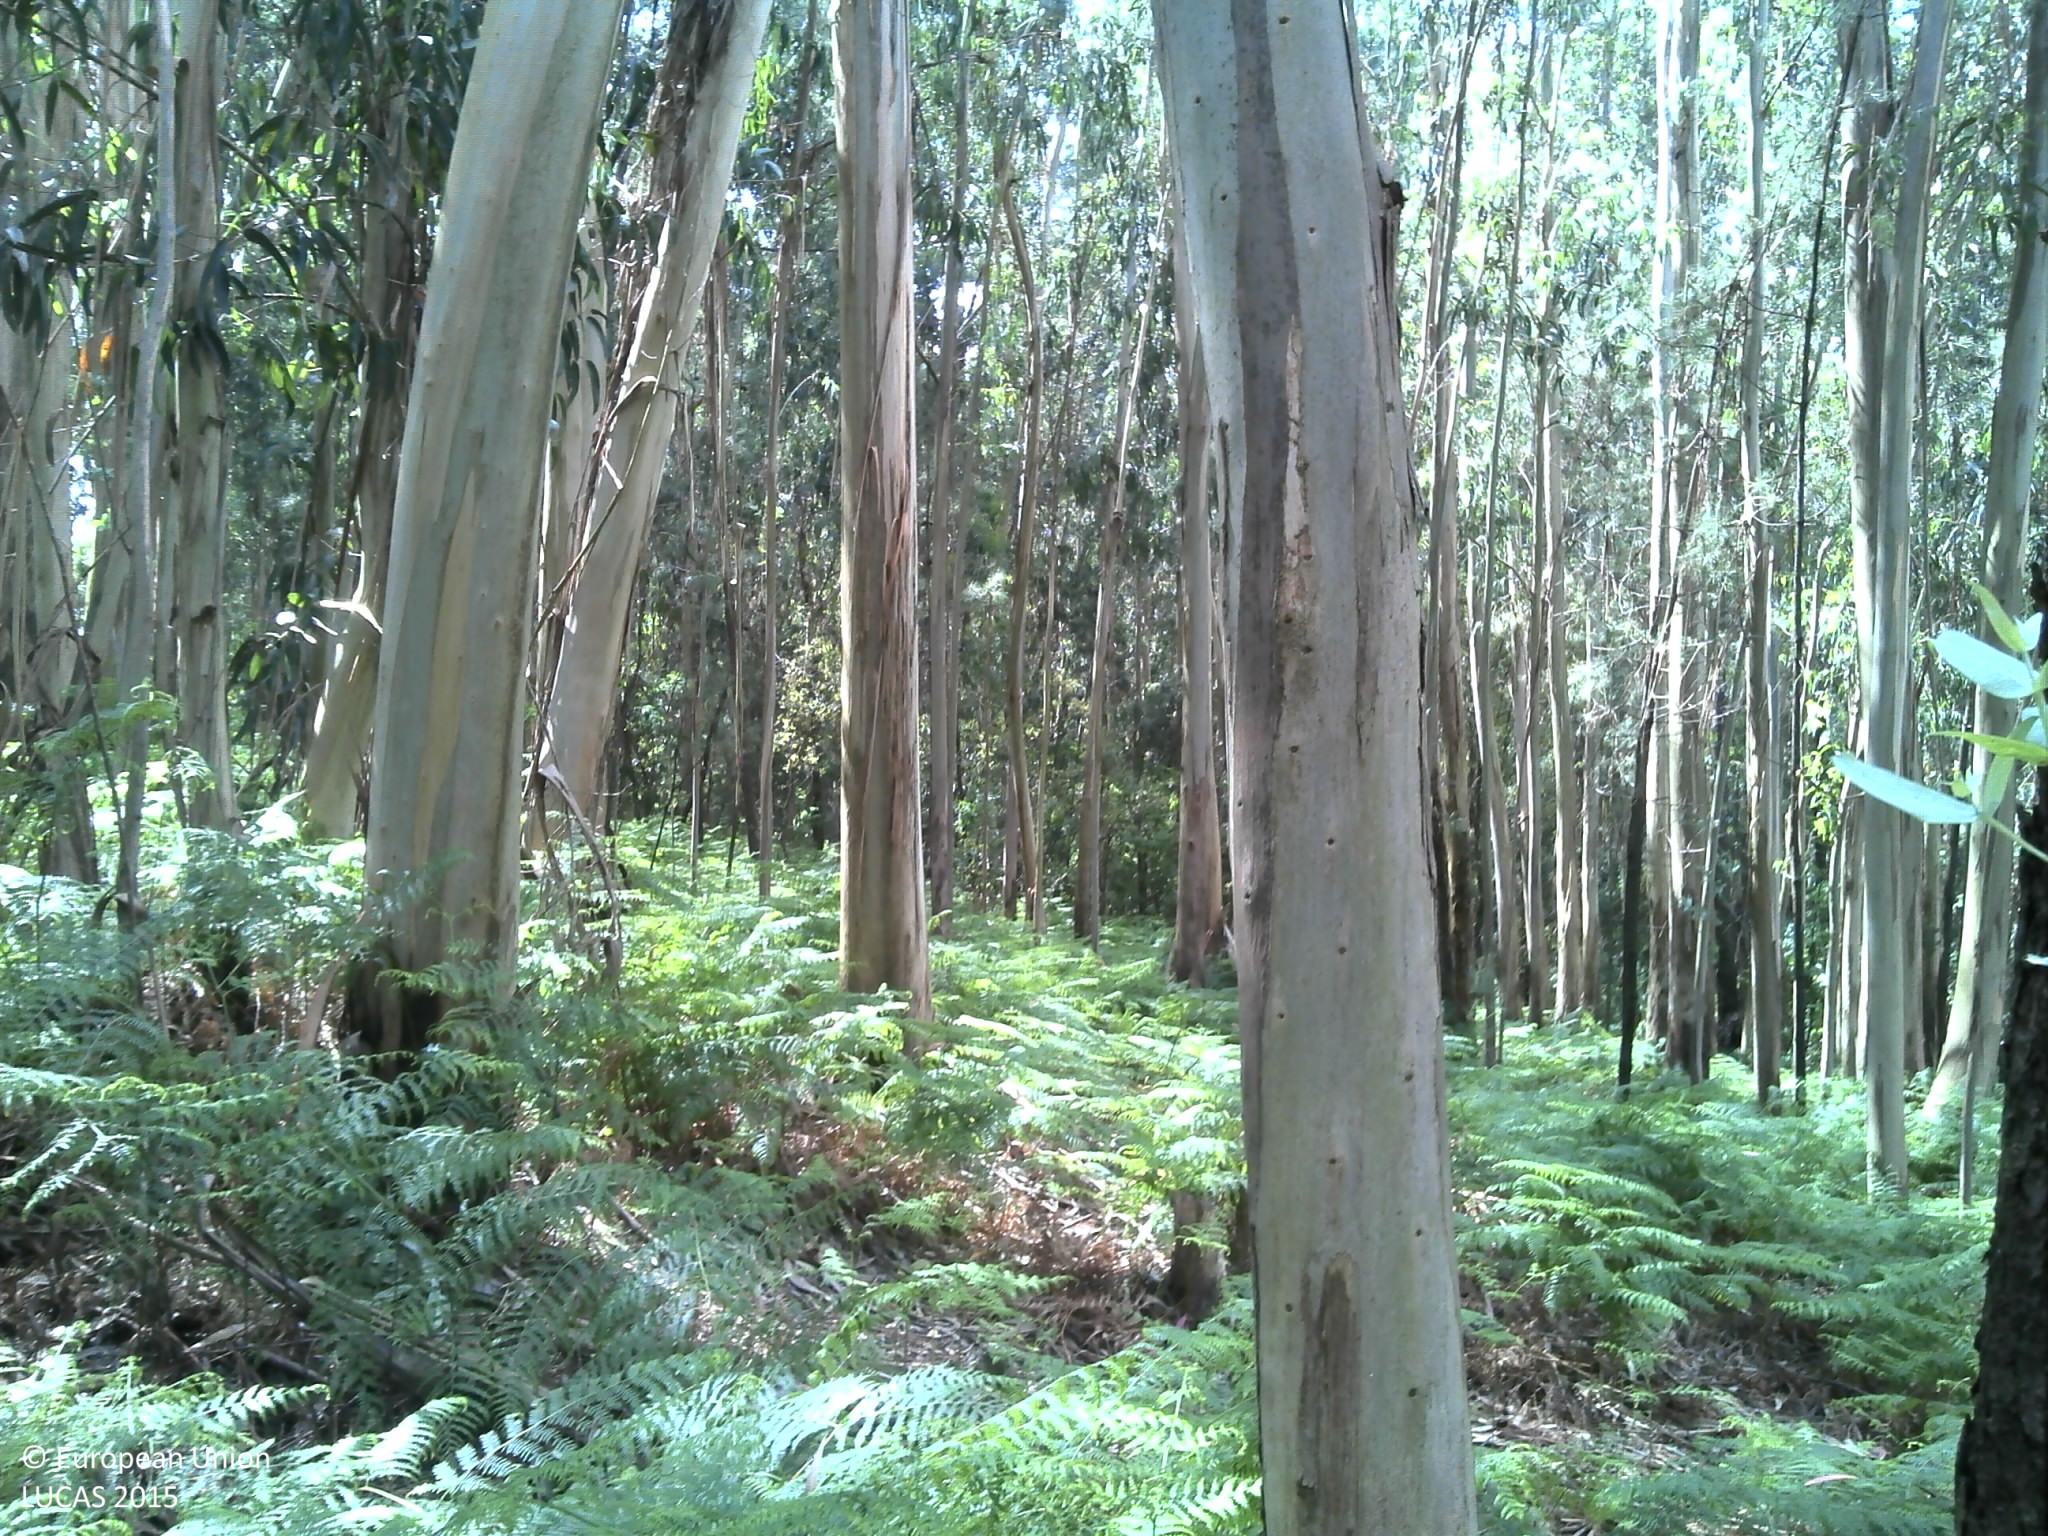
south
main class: Woodland
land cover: Broadleaved woodland
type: exotic forest
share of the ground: 50 - 75 %
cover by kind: broadleaved forest trees 75 %, shrubs 10 %, unconsolidated bare surface 10 %, herbaceous plants 5 %
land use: Forestry
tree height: > 5 m
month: May
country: PT
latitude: 40.8632
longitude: -8.3757
